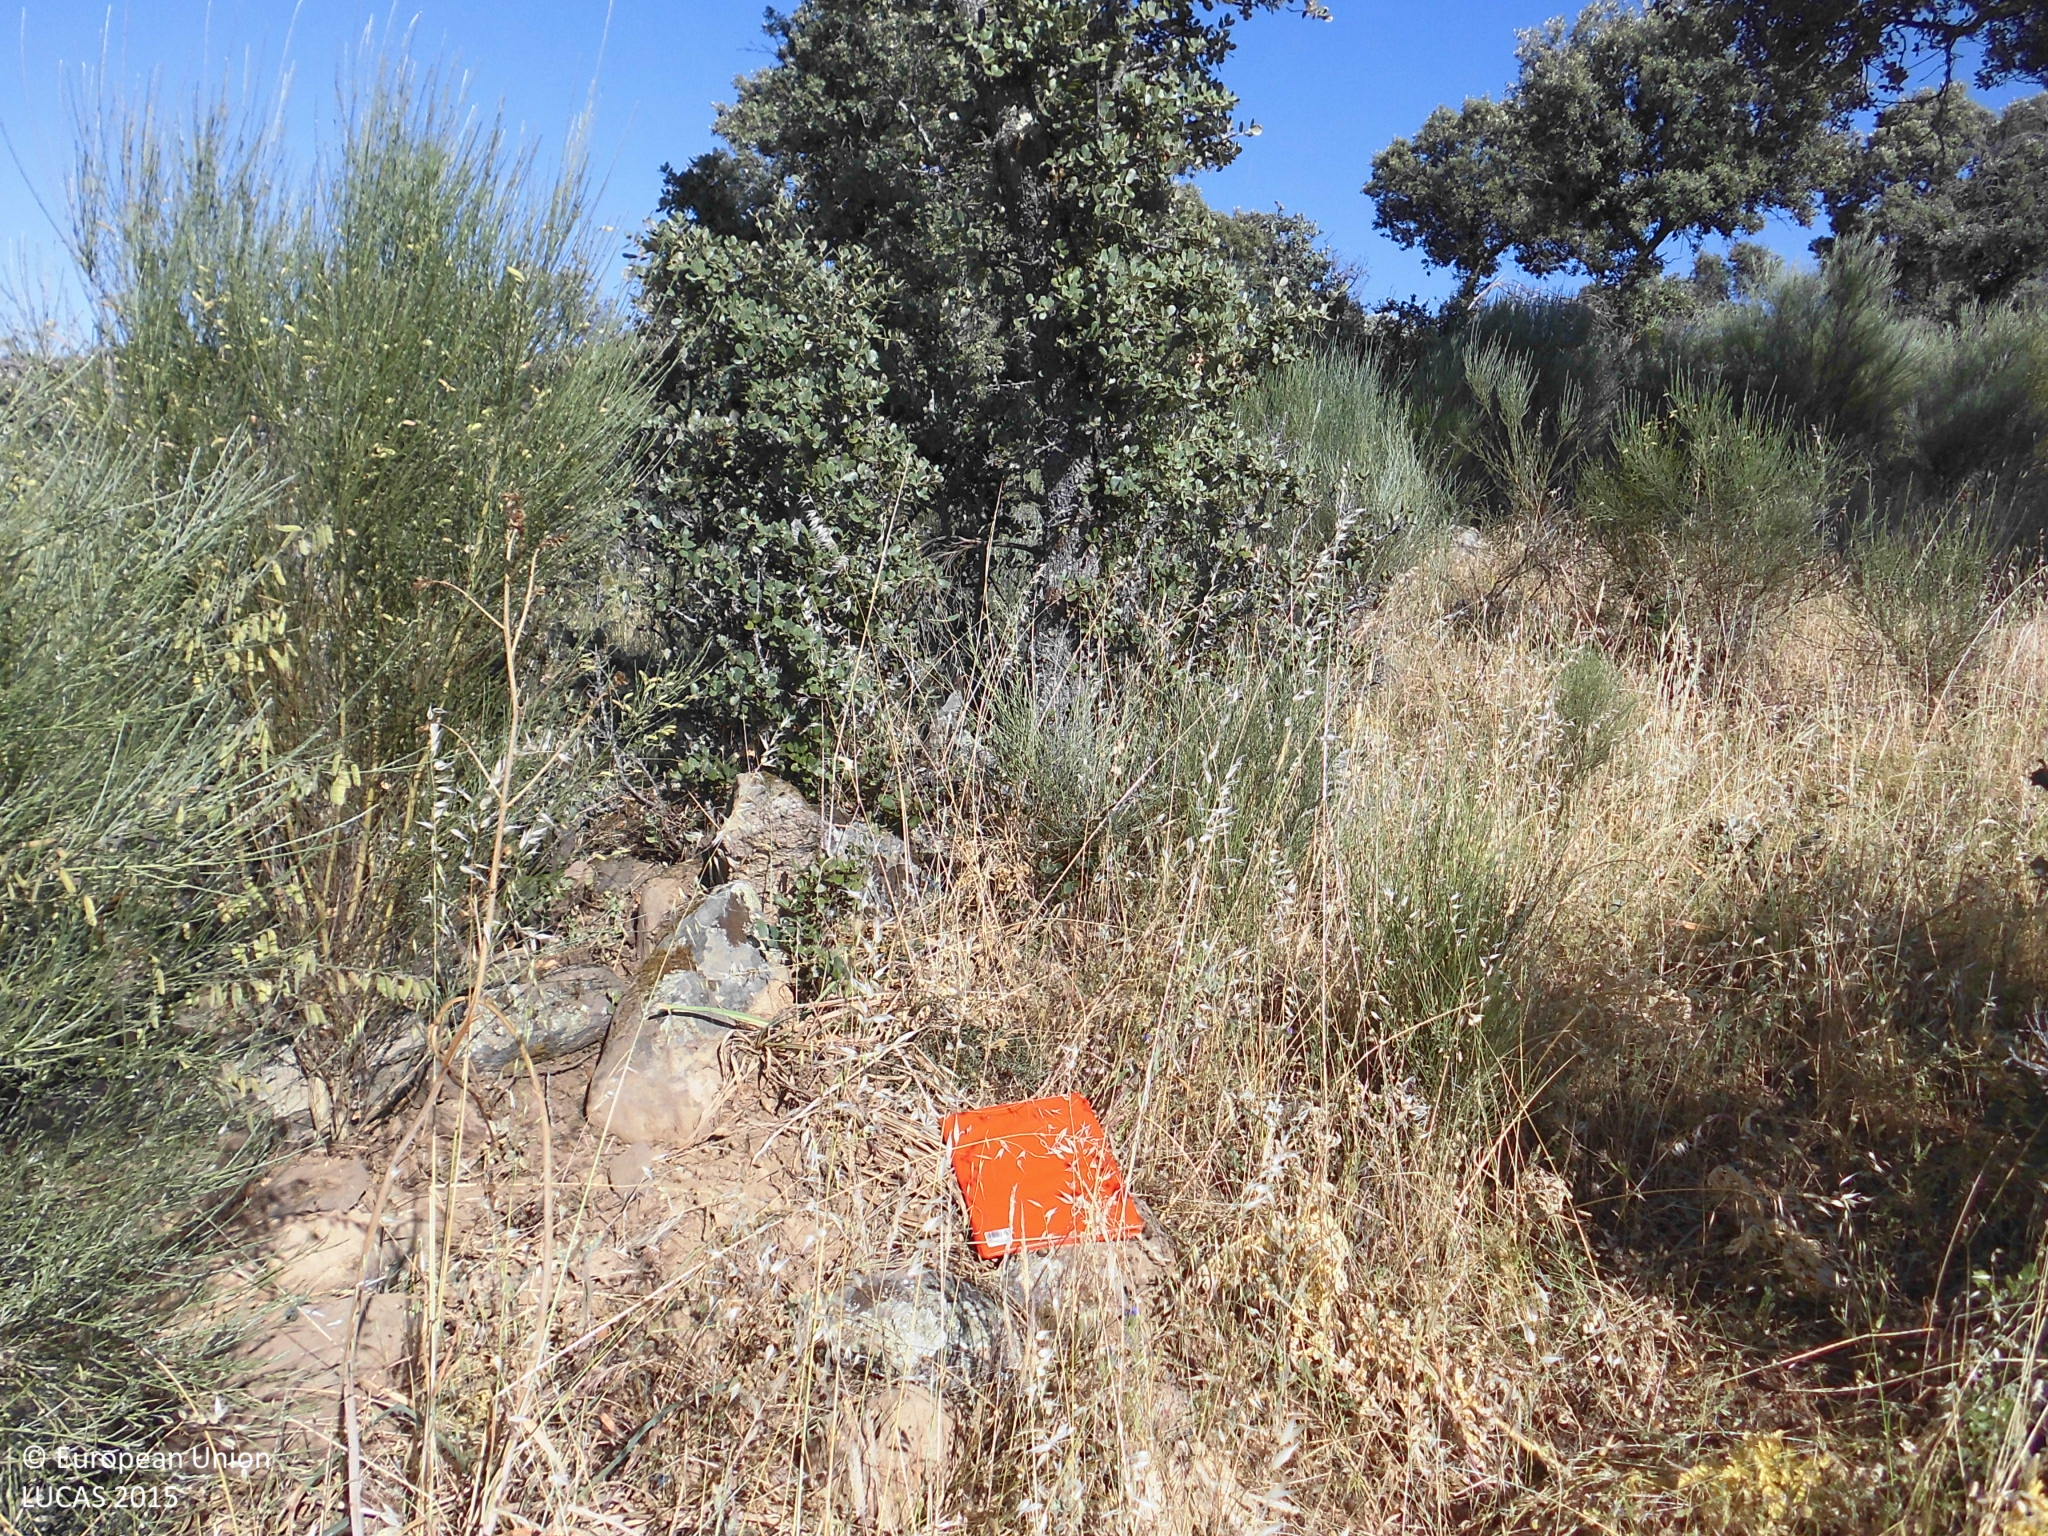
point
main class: Woodland
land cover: Broadleaved woodland
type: broadleaved evergreen forest
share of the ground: 25 - 50 %
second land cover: Grassland without tree/shrub cover
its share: > 75 %
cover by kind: herbaceous plants 50 %, broadleaved forest trees 30 %, shrubs 20 %
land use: Forestry
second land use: Agriculture (excluding fallow land and kitchen gardens)
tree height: > 5 m
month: May
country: ES
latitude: 39.4318
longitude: -6.0585
